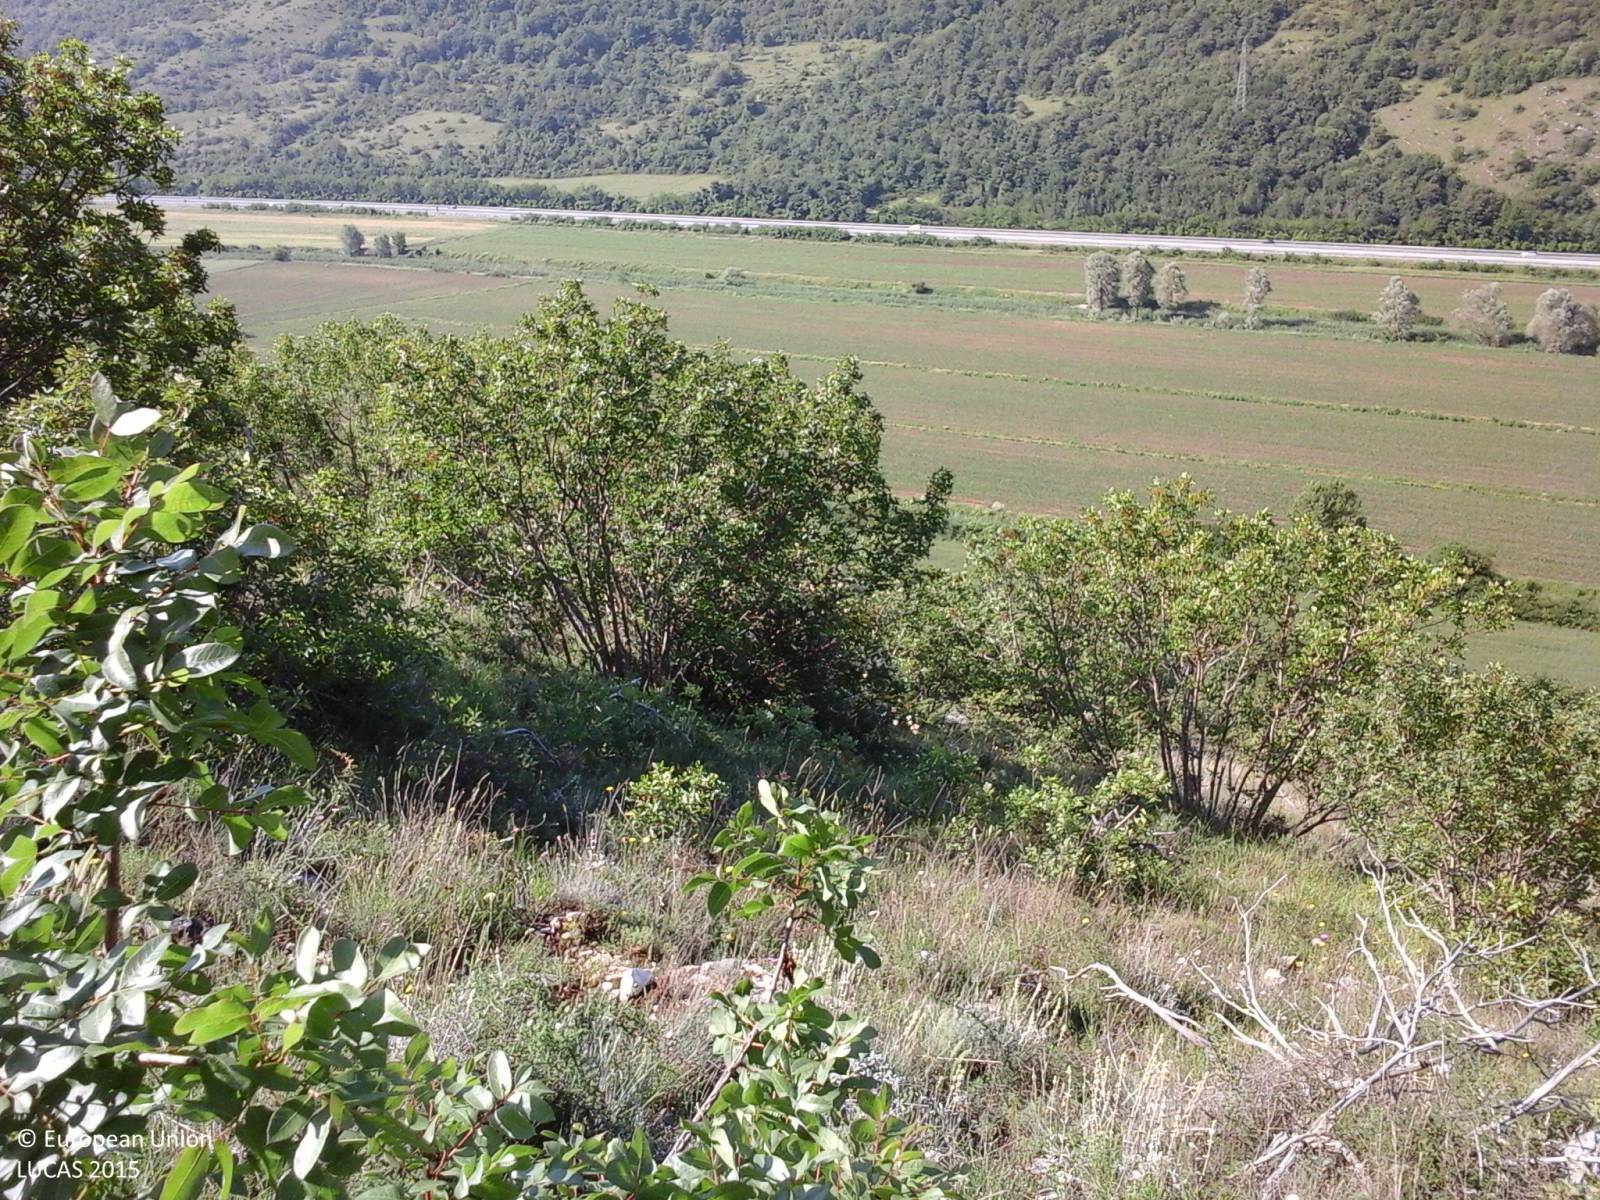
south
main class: Shrubland
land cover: Shrubland without tree cover
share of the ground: > 75 %
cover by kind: shrubs 70 %, herbaceous plants 25 %, unconsolidated bare surface 5 %
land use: Semi-natural and natural areas not in use
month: June
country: IT
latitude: 42.1117
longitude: 13.3145
